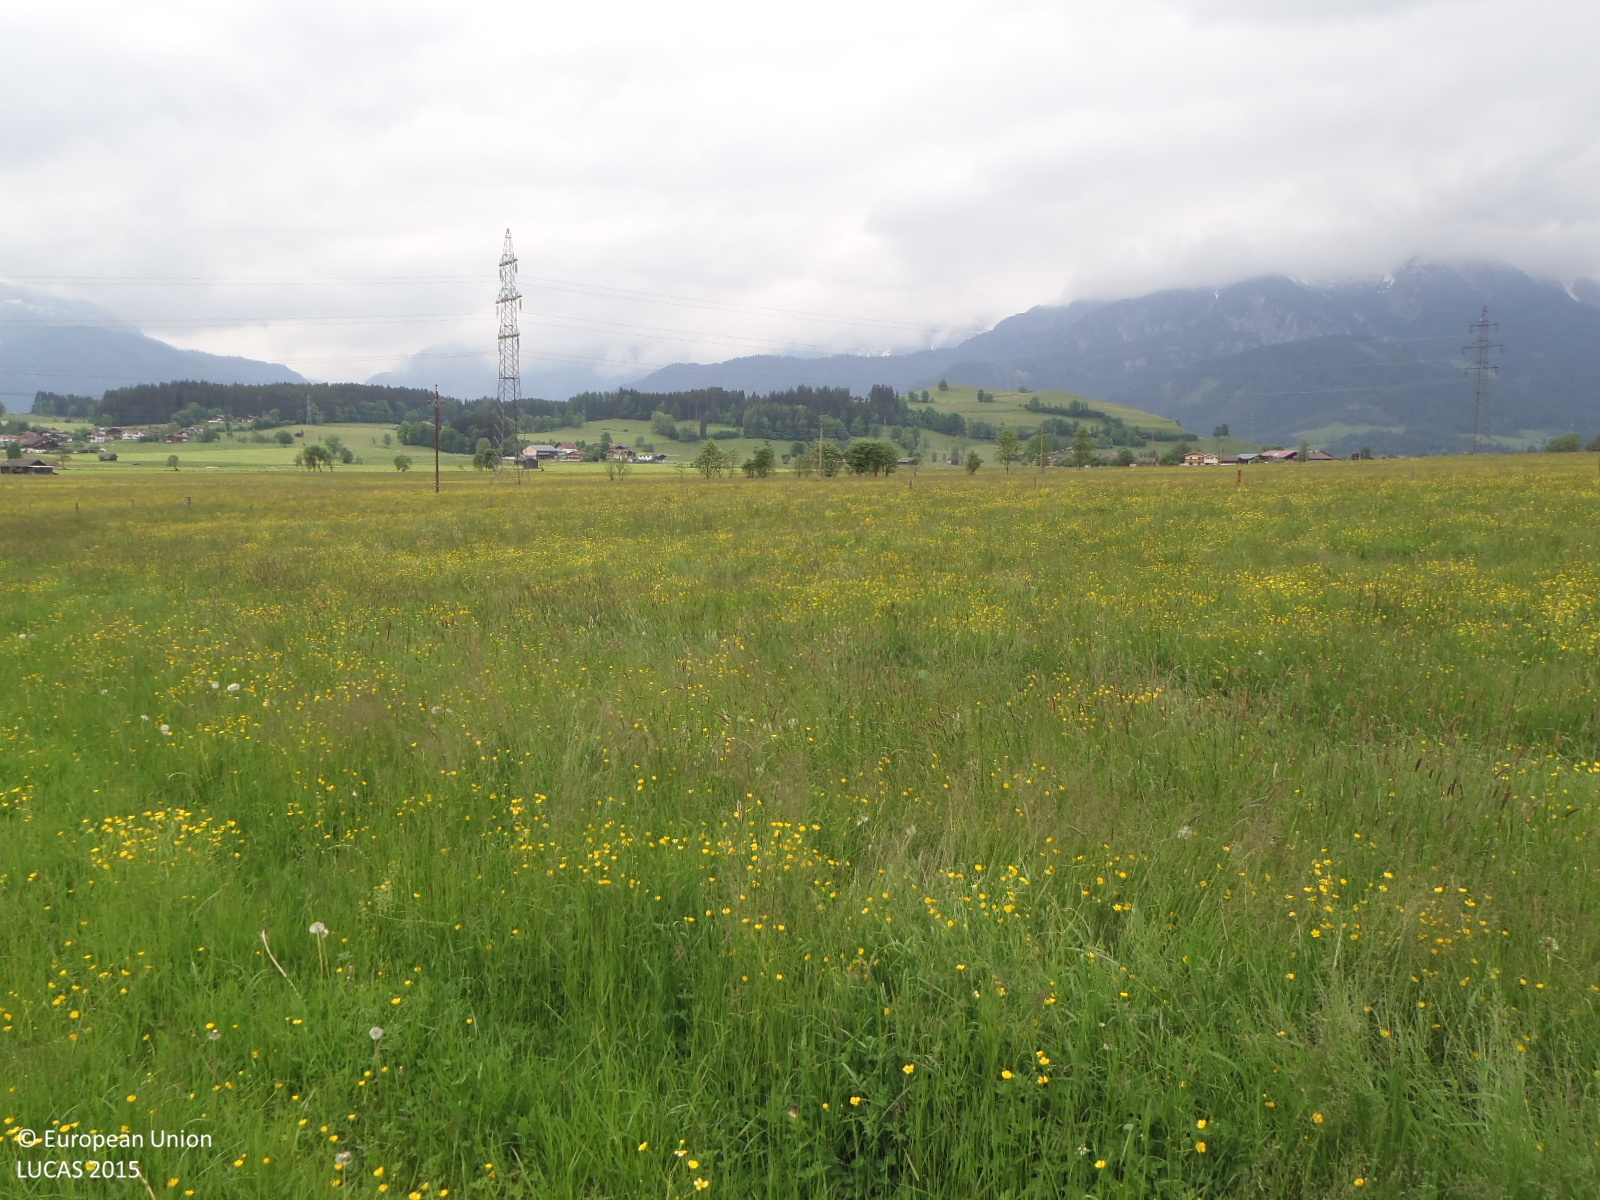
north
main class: Grassland
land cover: Grassland without tree/shrub cover
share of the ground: > 75 %
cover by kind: herbaceous plants 100 %
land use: Agriculture (excluding fallow land and kitchen gardens)
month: May
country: AT
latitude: 47.3944
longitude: 12.8466
